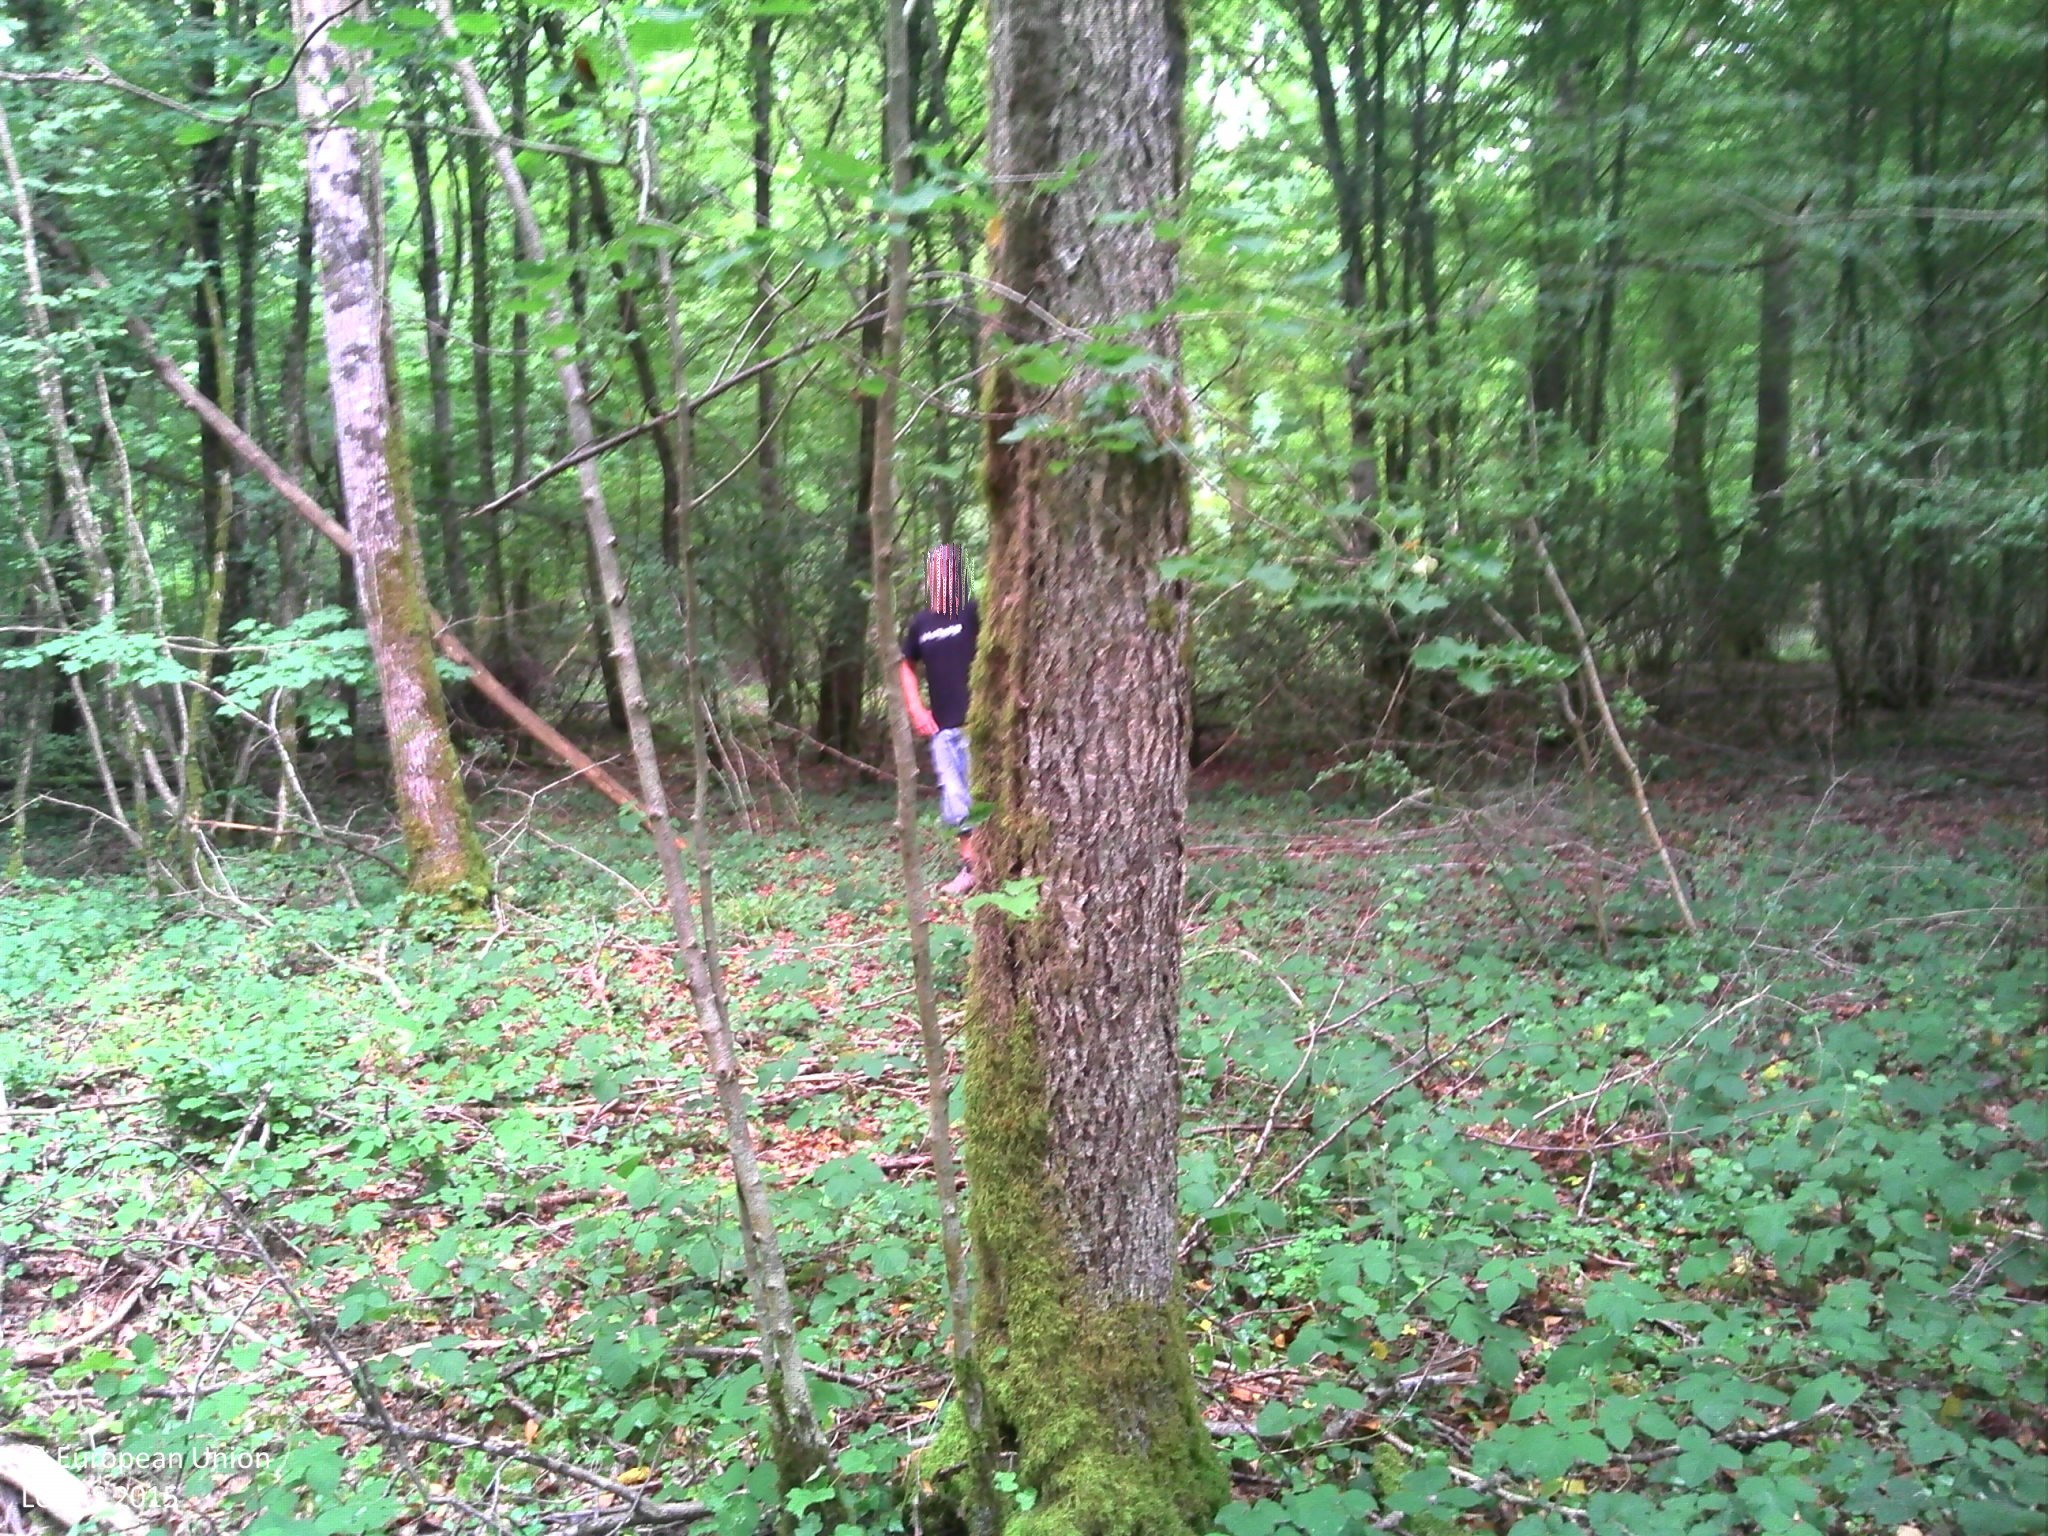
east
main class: Woodland
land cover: Broadleaved woodland
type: mesophytic deciduous forest
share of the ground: > 75 %
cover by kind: broadleaved forest trees 85 %, herbaceous plants 10 %, lichens and mosses 5 %
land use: Forestry
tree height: > 5 m
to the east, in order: Broadleaved woodland; Tracks; Broadleaved woodland
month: July
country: FR
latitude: 48.1468
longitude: 5.0125
